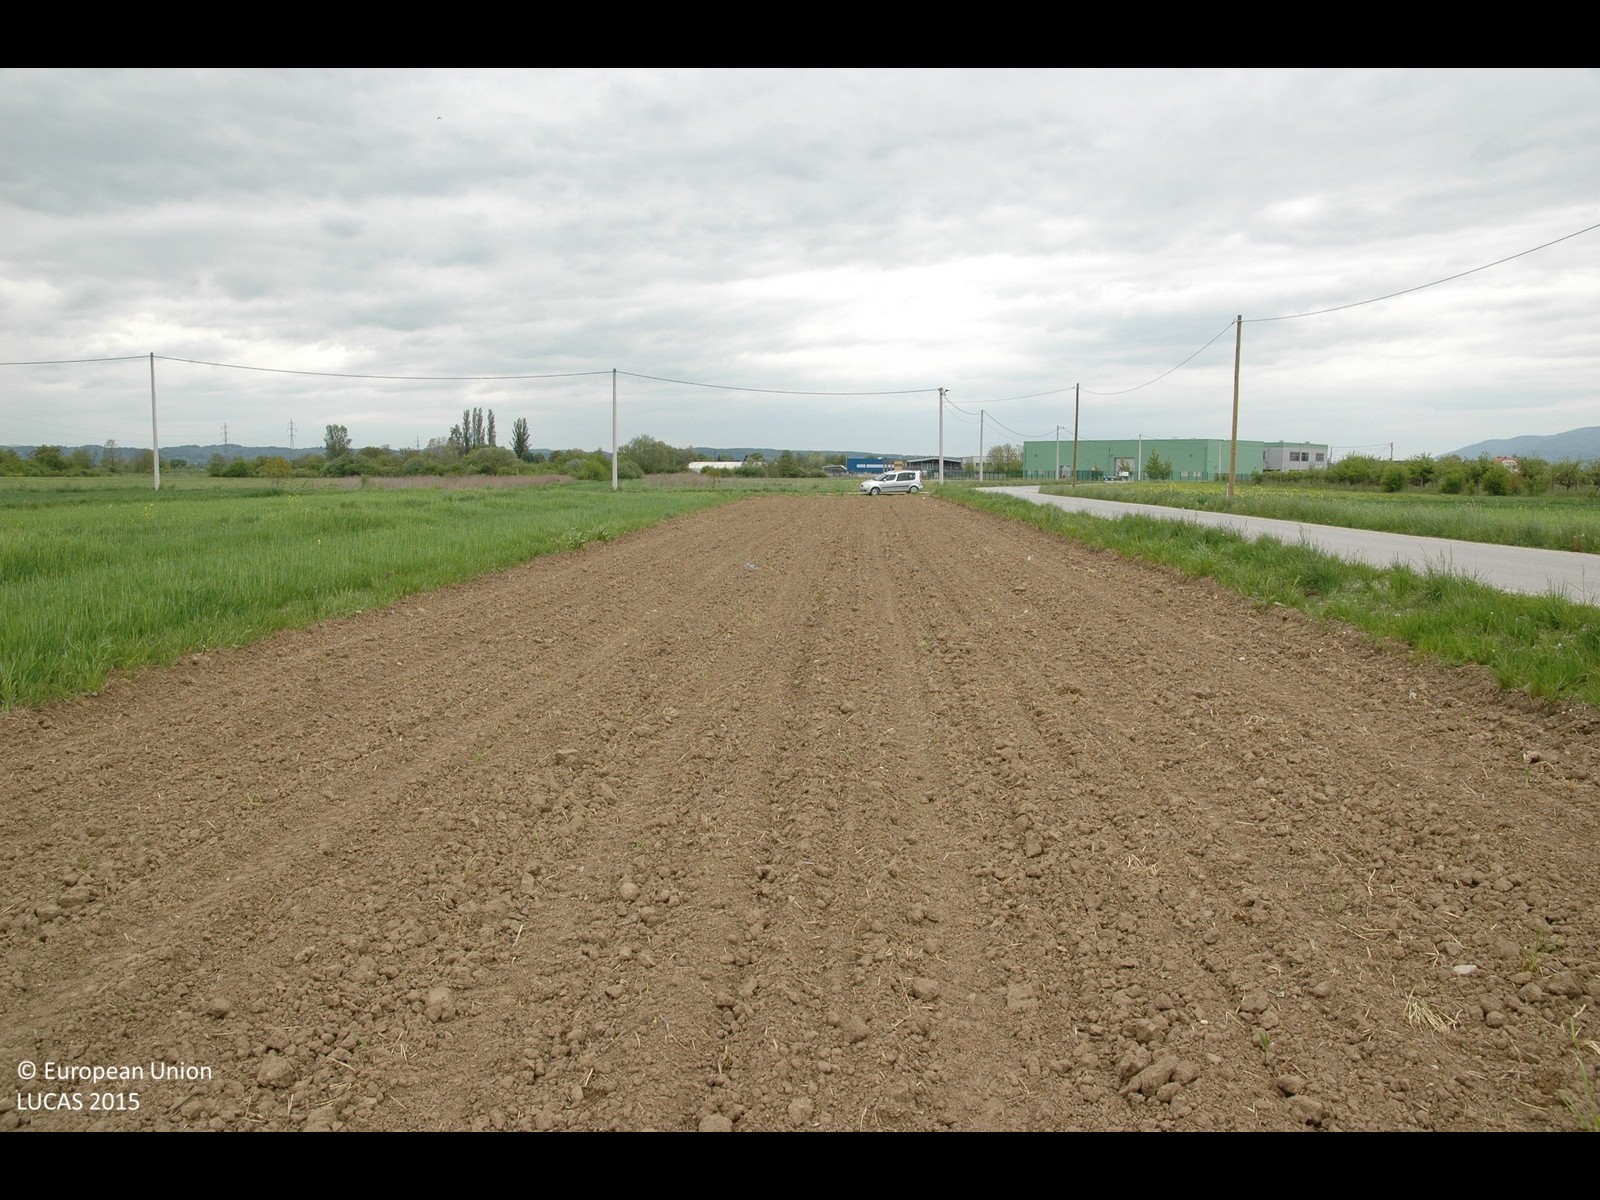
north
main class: Cropland
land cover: Maize
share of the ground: < 10 %
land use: Agriculture (excluding fallow land and kitchen gardens)
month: May
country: HR
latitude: 45.8187
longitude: 15.7248
